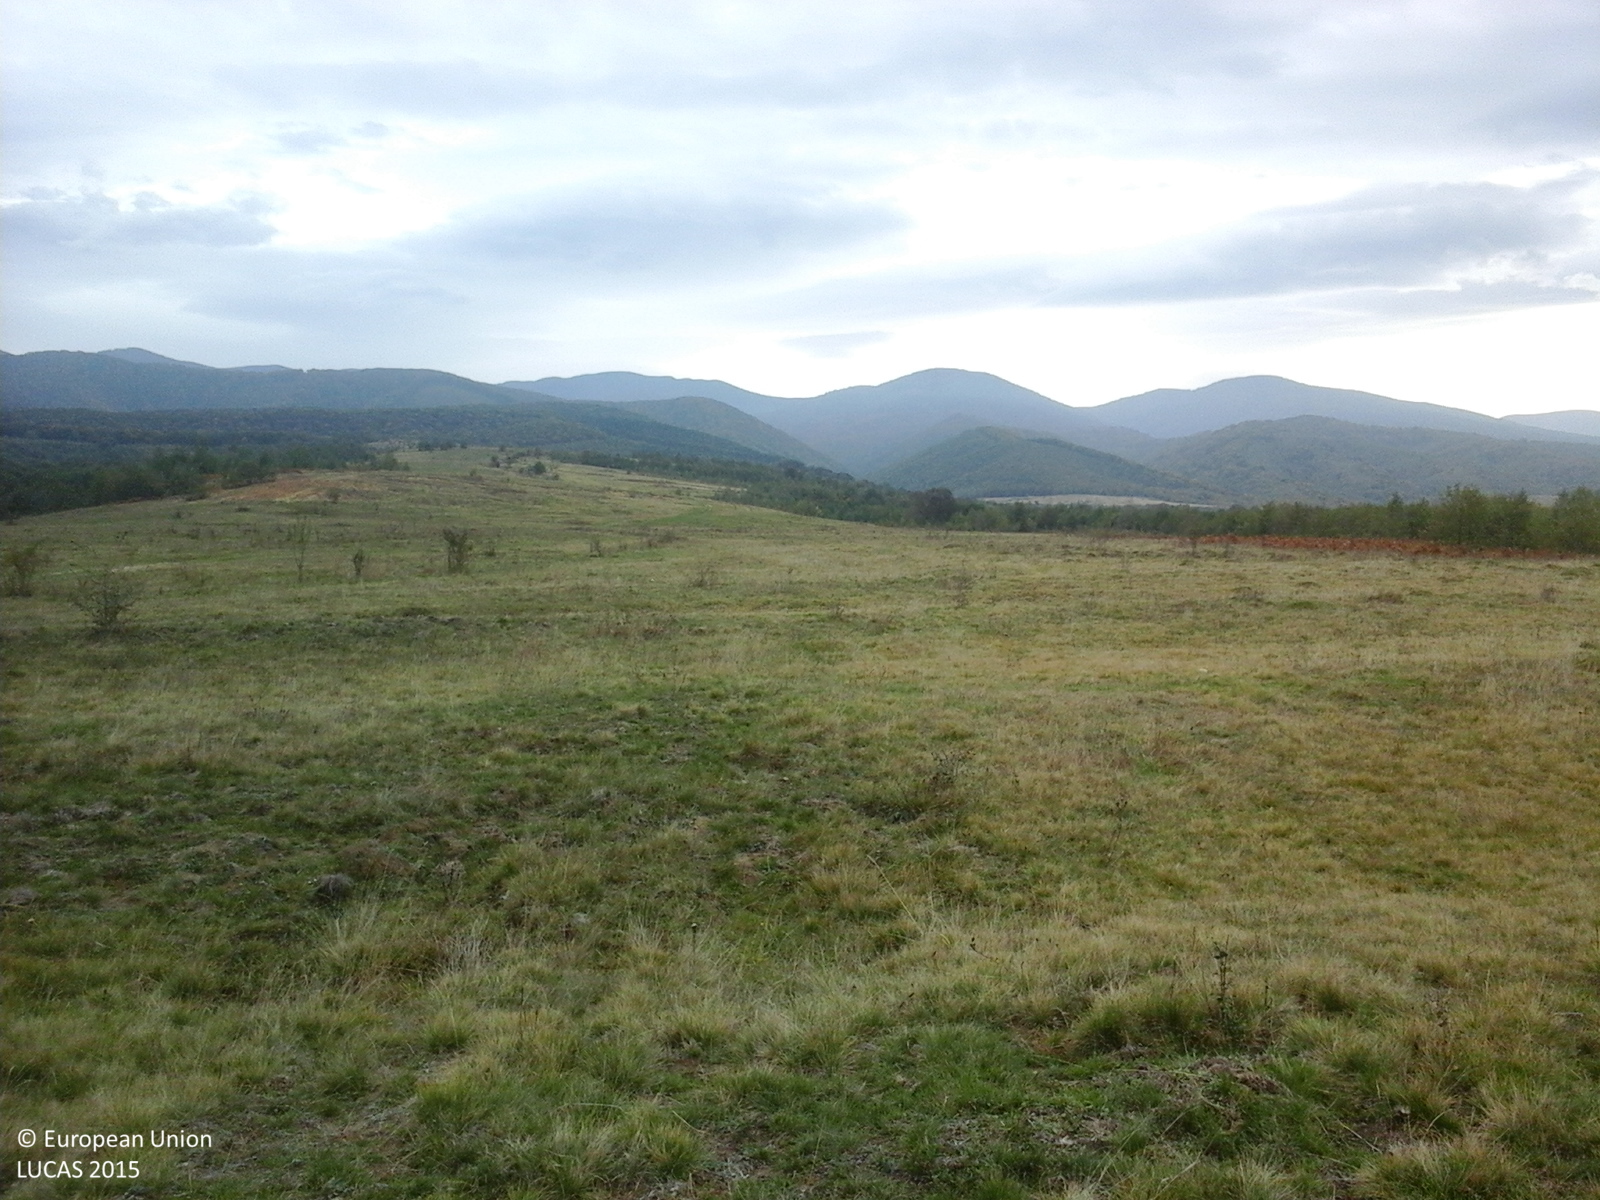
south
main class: Grassland
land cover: Grassland without tree/shrub cover
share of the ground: > 75 %
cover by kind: herbaceous plants 100 %
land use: Agriculture (excluding fallow land and kitchen gardens)
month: October
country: RO
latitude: 45.7272
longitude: 25.1151
